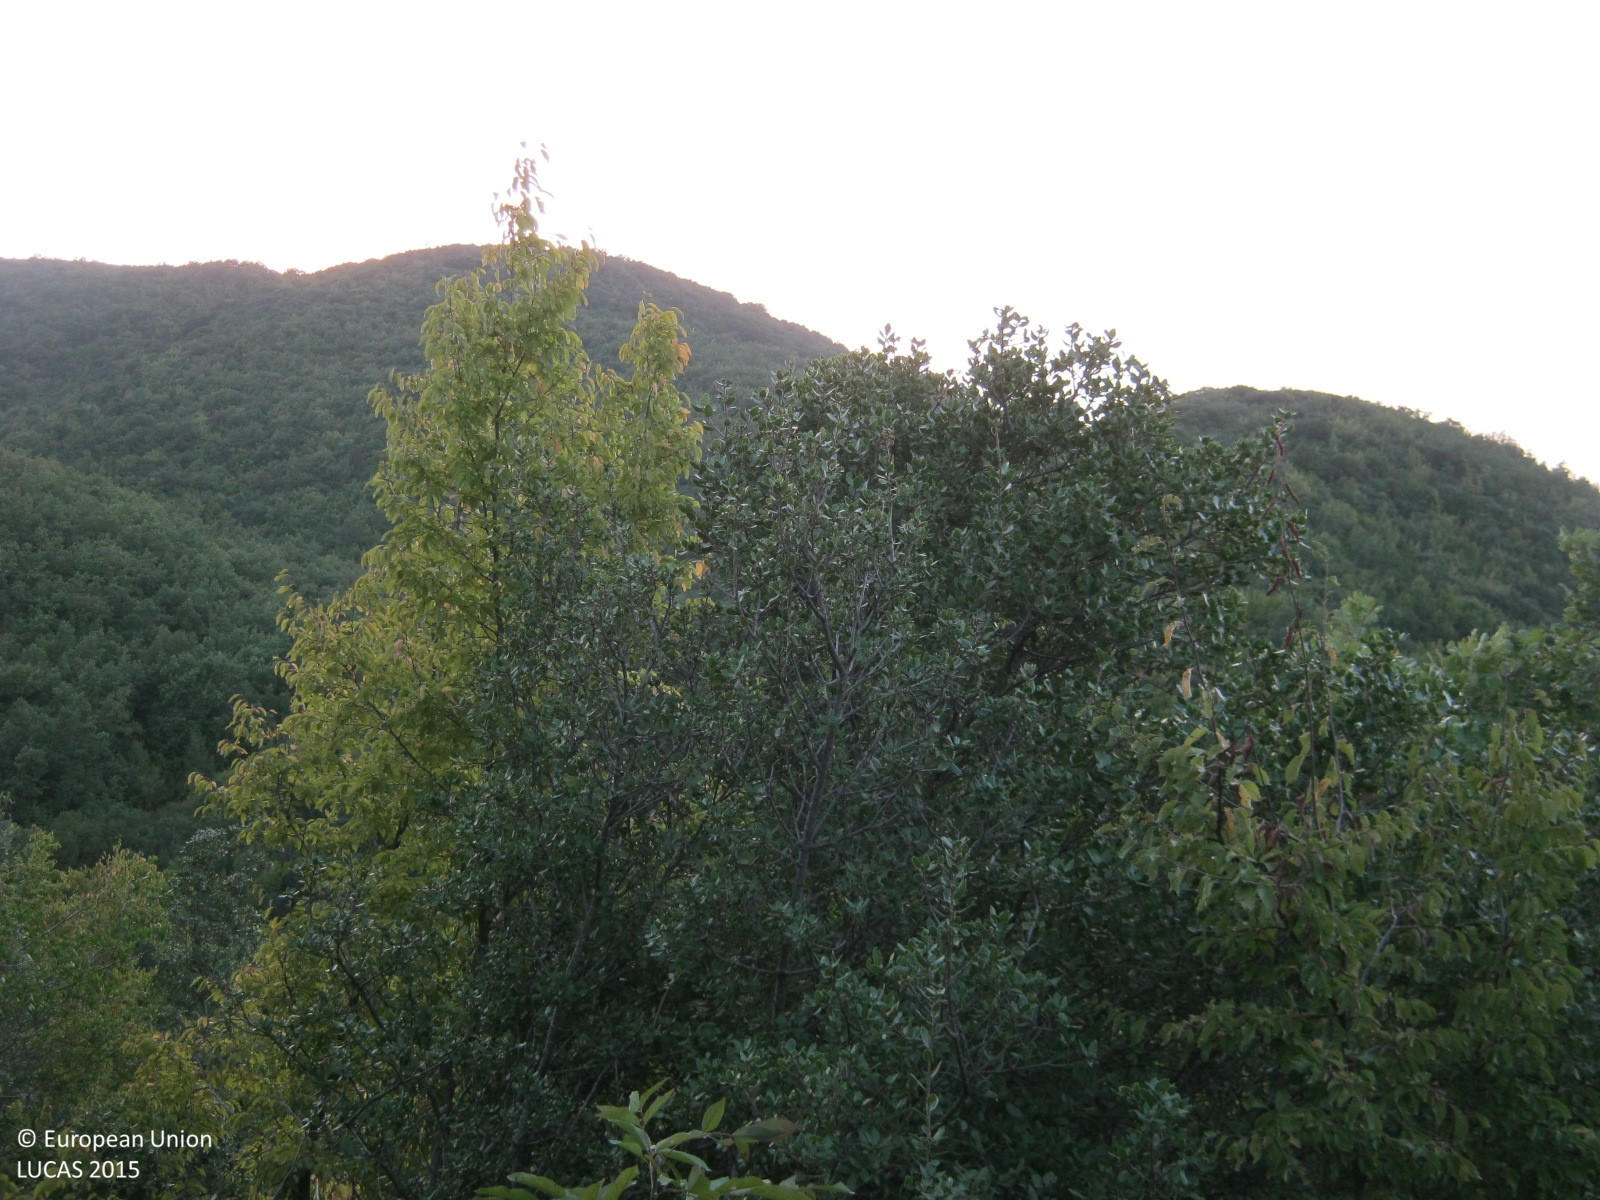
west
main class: Woodland
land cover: Broadleaved woodland
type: thermophilous deciduous forest
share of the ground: > 75 %
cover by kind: broadleaved forest trees 90 %, coniferous forest trees 5 %, shrubs 5 %
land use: Forestry
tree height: > 5 m
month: September
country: GR
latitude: 40.5029
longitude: 23.3567
